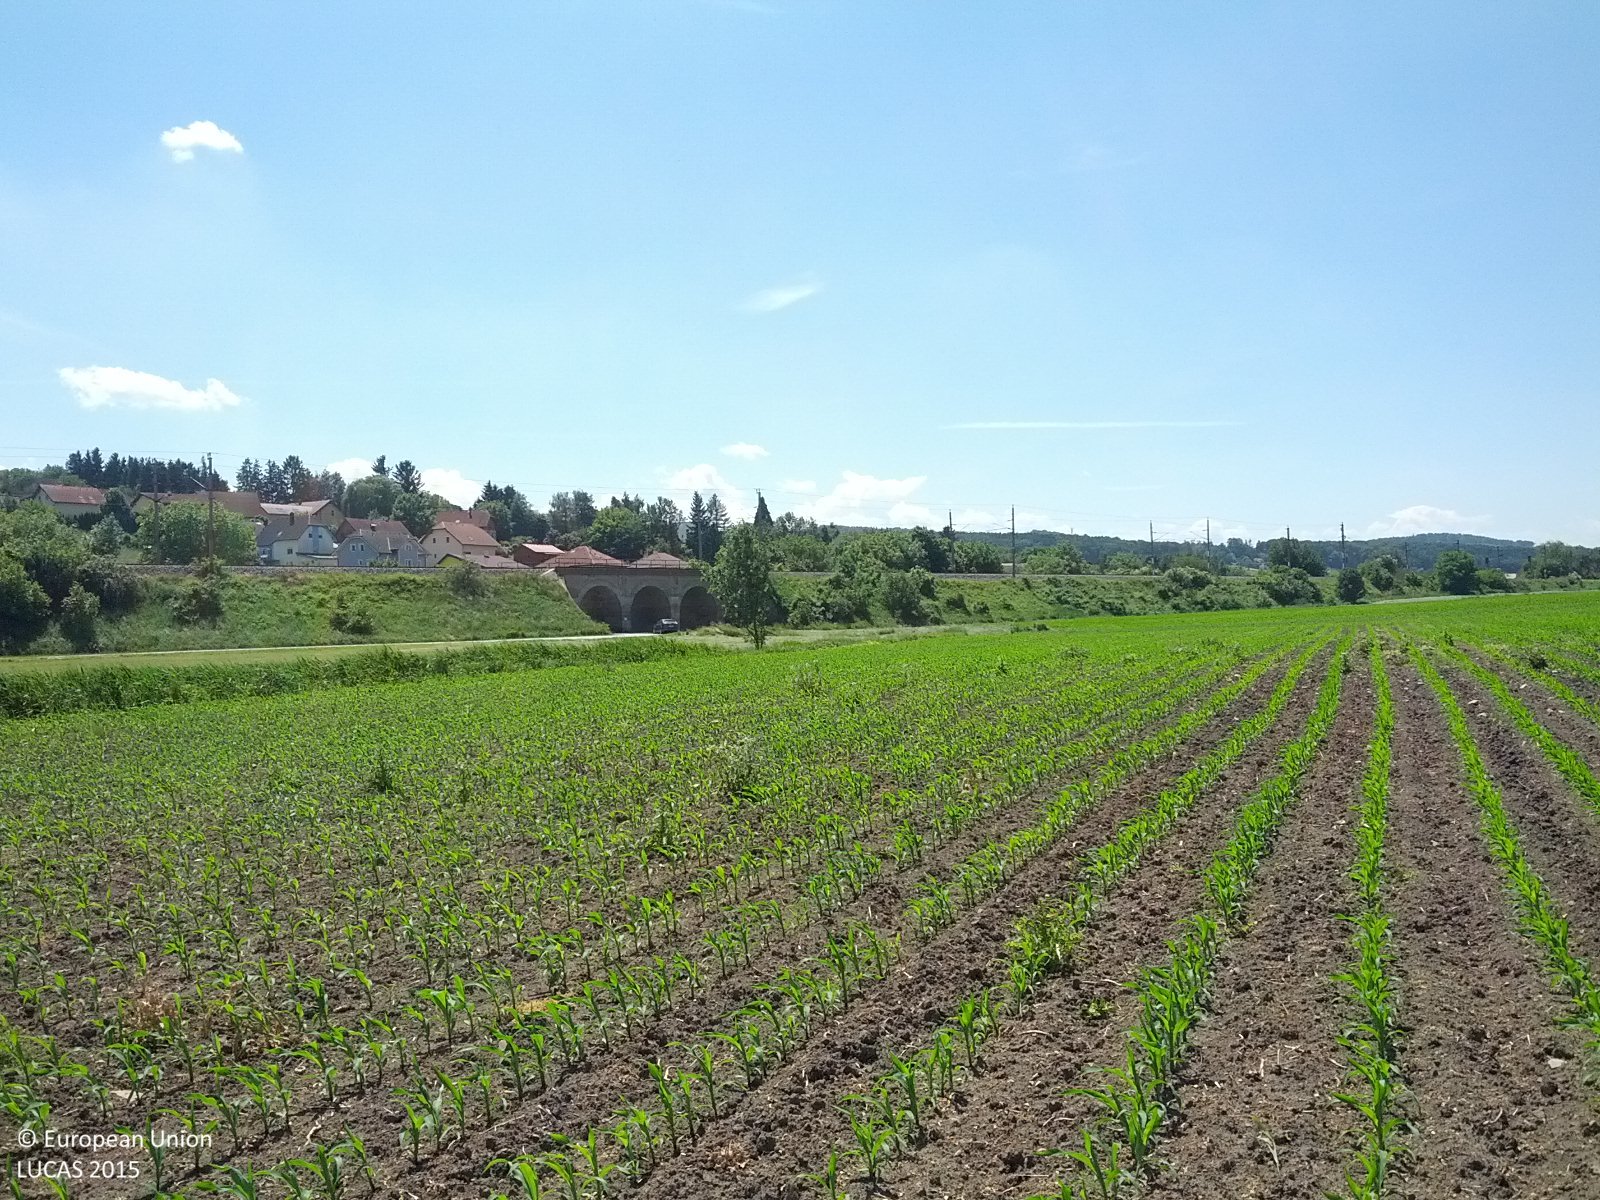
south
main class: Cropland
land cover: Maize
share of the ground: < 10 %
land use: Agriculture (excluding fallow land and kitchen gardens)
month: June
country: AT
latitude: 48.1942
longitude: 15.8553
